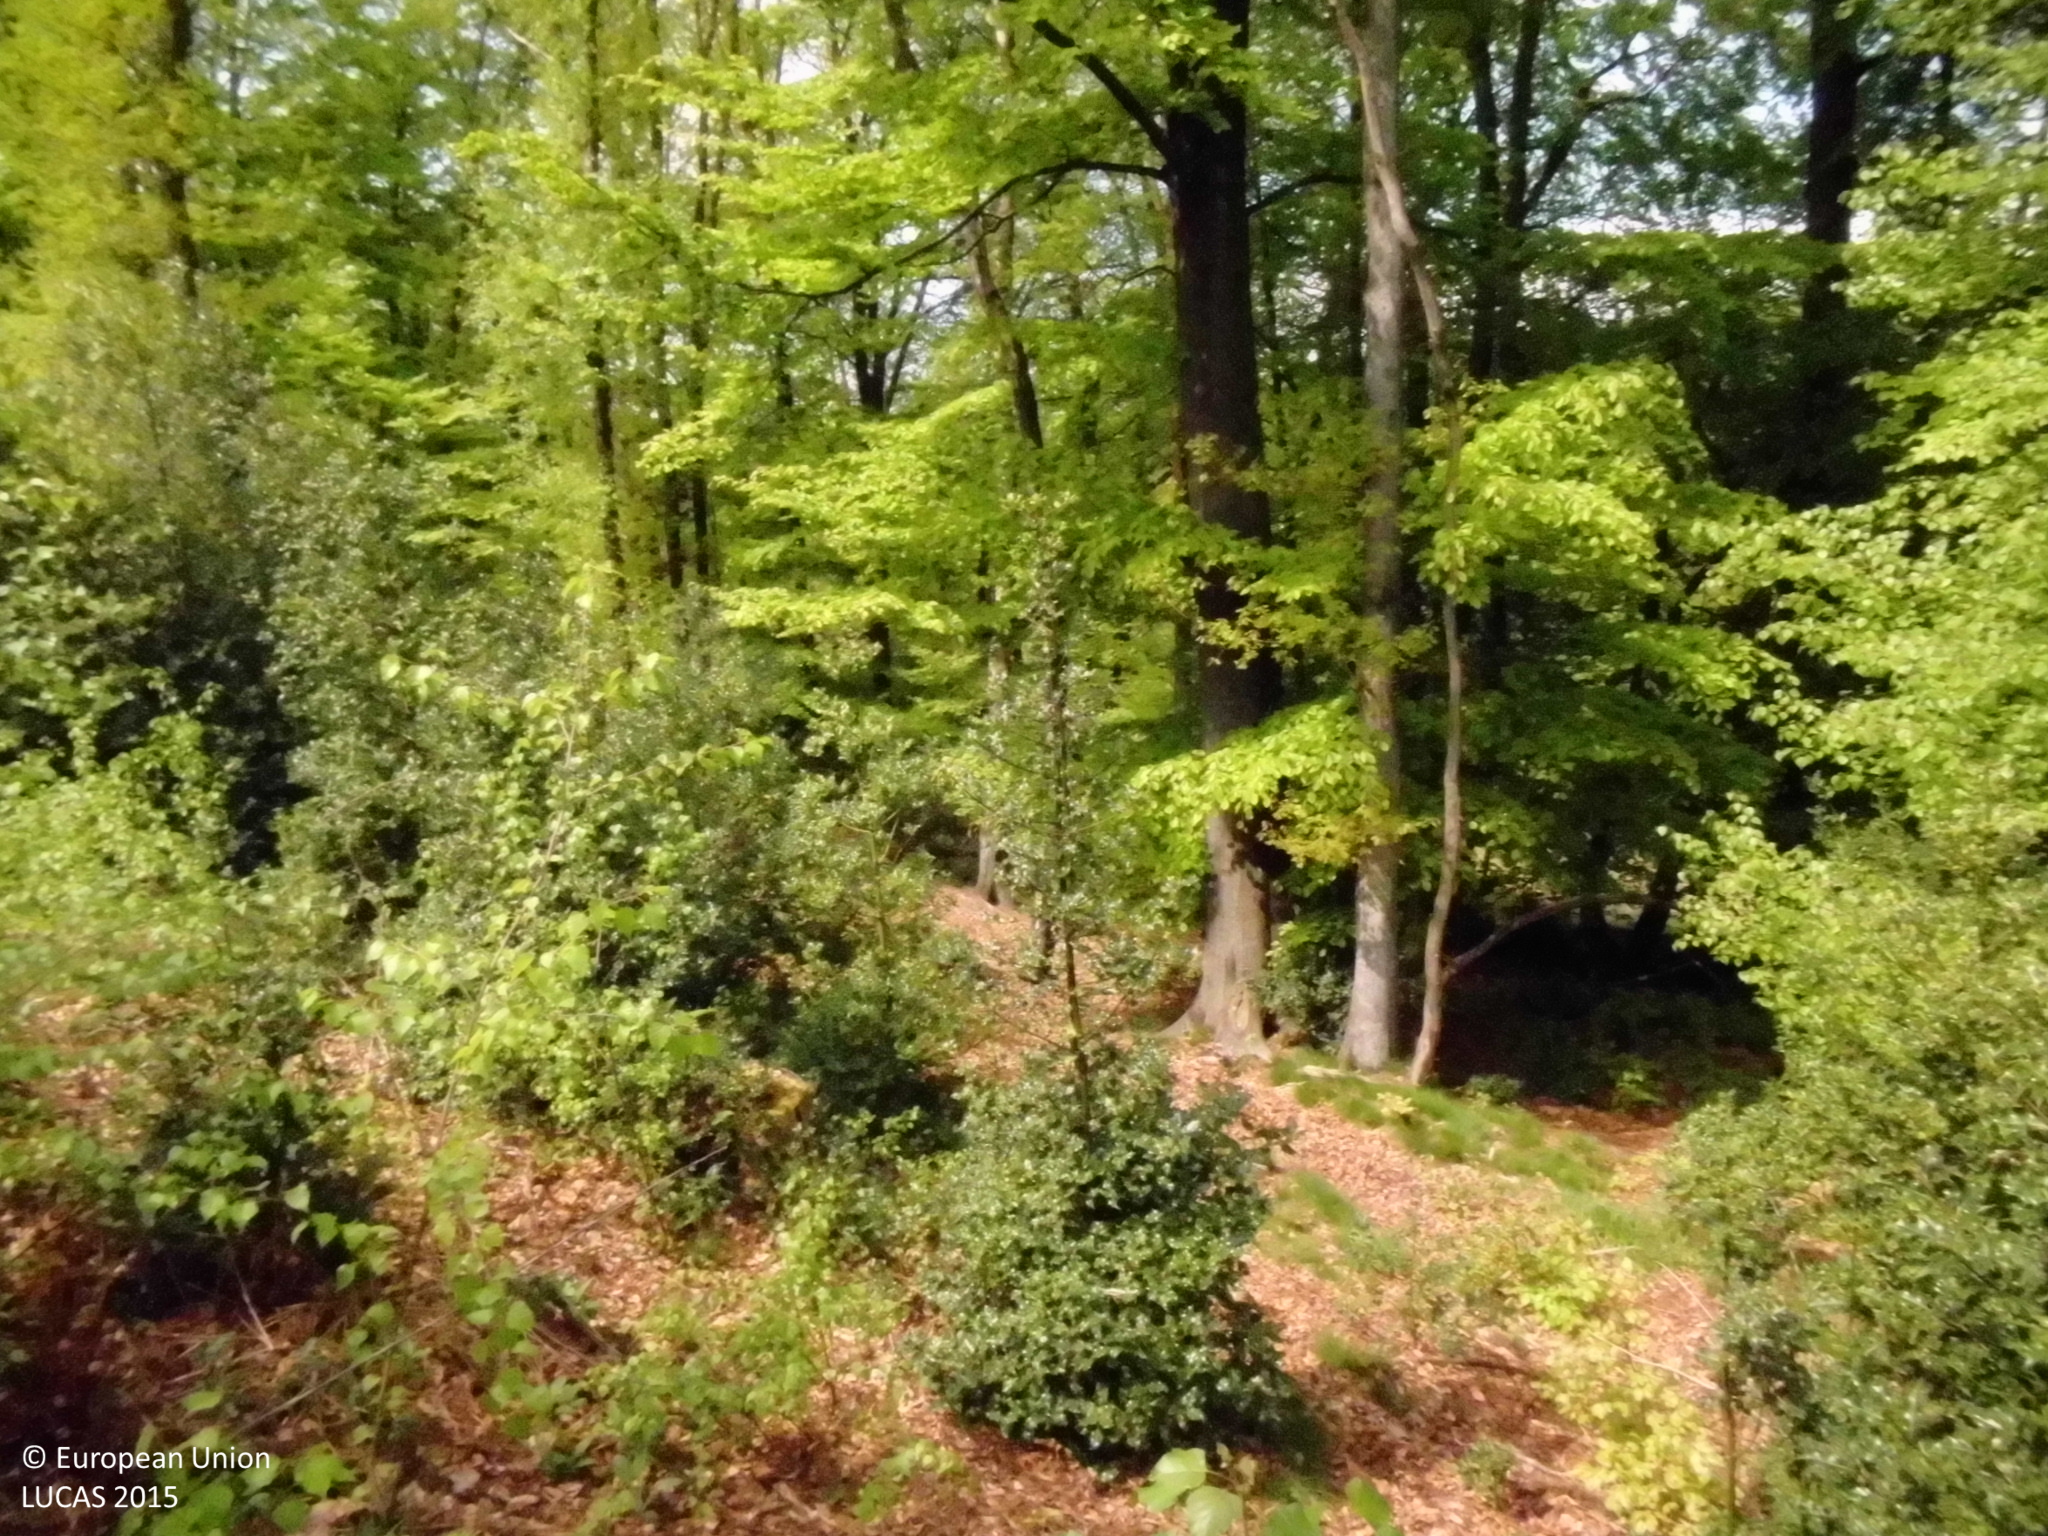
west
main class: Woodland
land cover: Broadleaved woodland
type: mesophytic deciduous forest
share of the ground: > 75 %
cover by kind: broadleaved forest trees 100 %
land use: Forestry
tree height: < 5 m
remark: Nursery
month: May
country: DE
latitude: 51.3060
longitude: 7.4038
